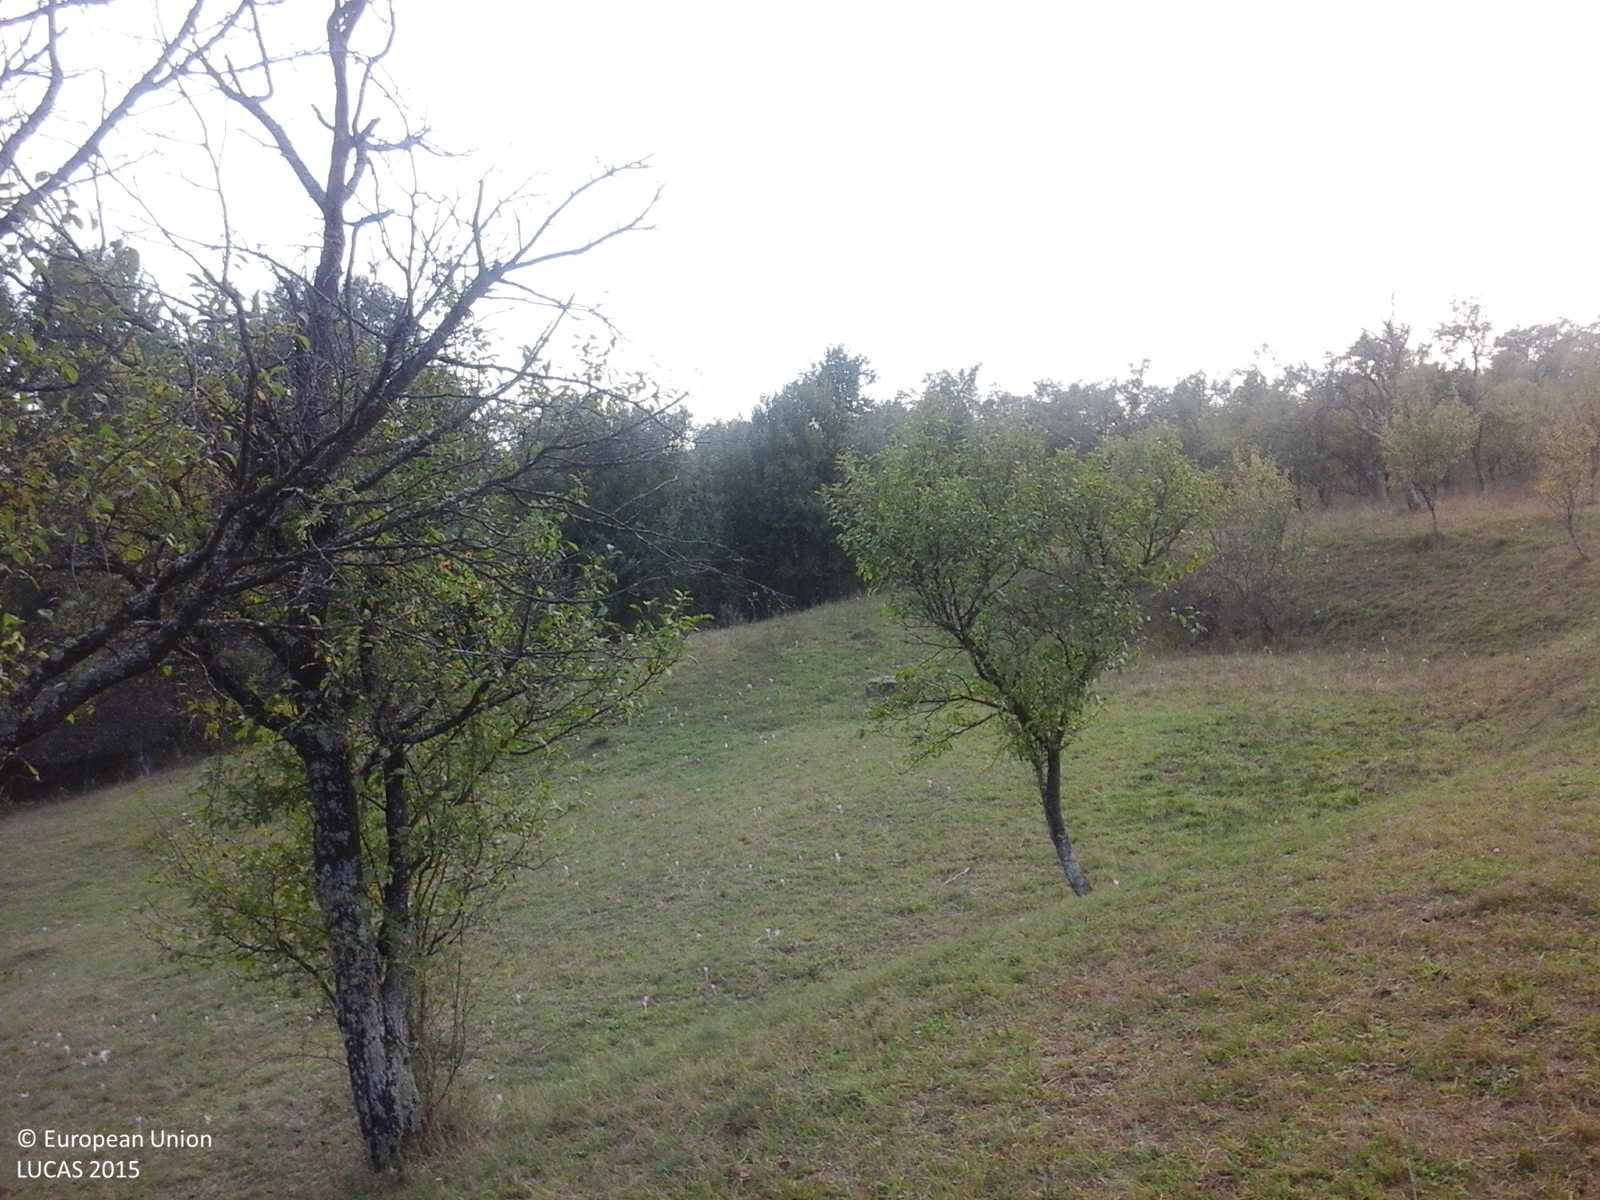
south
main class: Cropland
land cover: Other fruit trees and berries
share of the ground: 50 - 75 %
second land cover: Grassland without tree/shrub cover
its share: > 75 %
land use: Agriculture (excluding fallow land and kitchen gardens)
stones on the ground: < 10 %
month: September
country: RO
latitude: 47.0600
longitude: 23.0582
